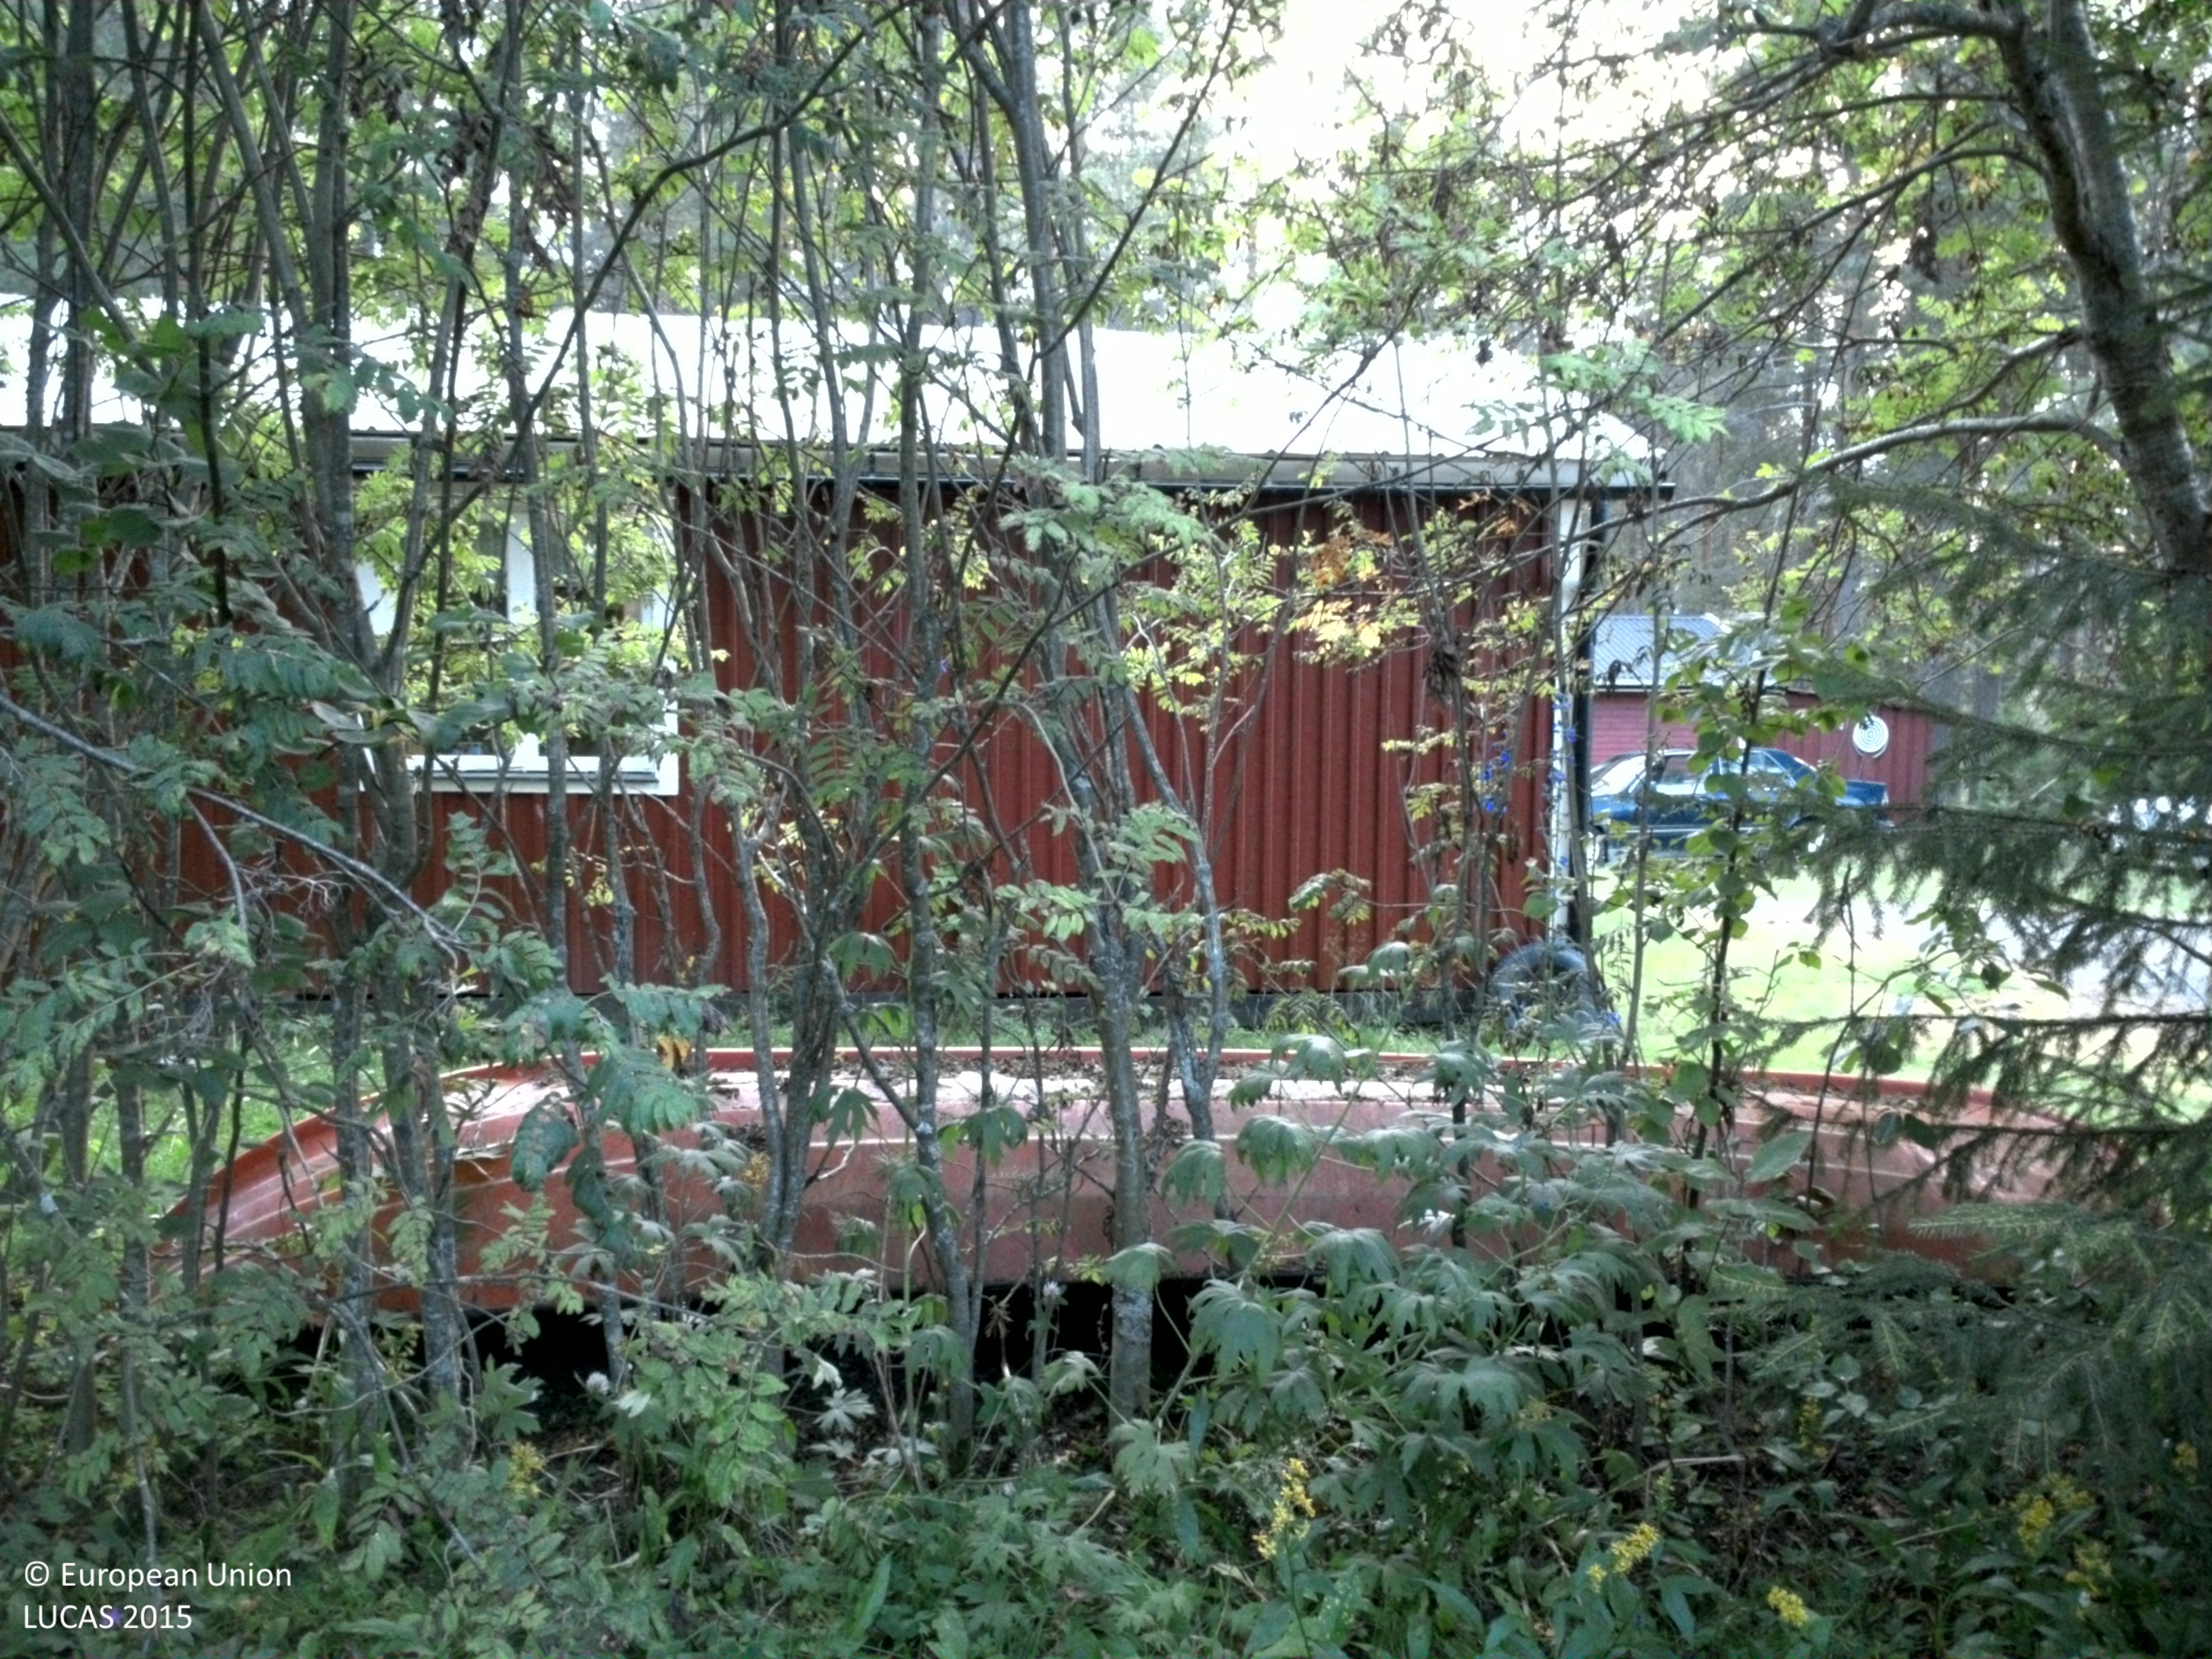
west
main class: Grassland
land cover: Grassland without tree/shrub cover
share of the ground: > 75 %
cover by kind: herbaceous plants 100 %
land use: Residential
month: August
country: SE
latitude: 66.2809
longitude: 22.8331
